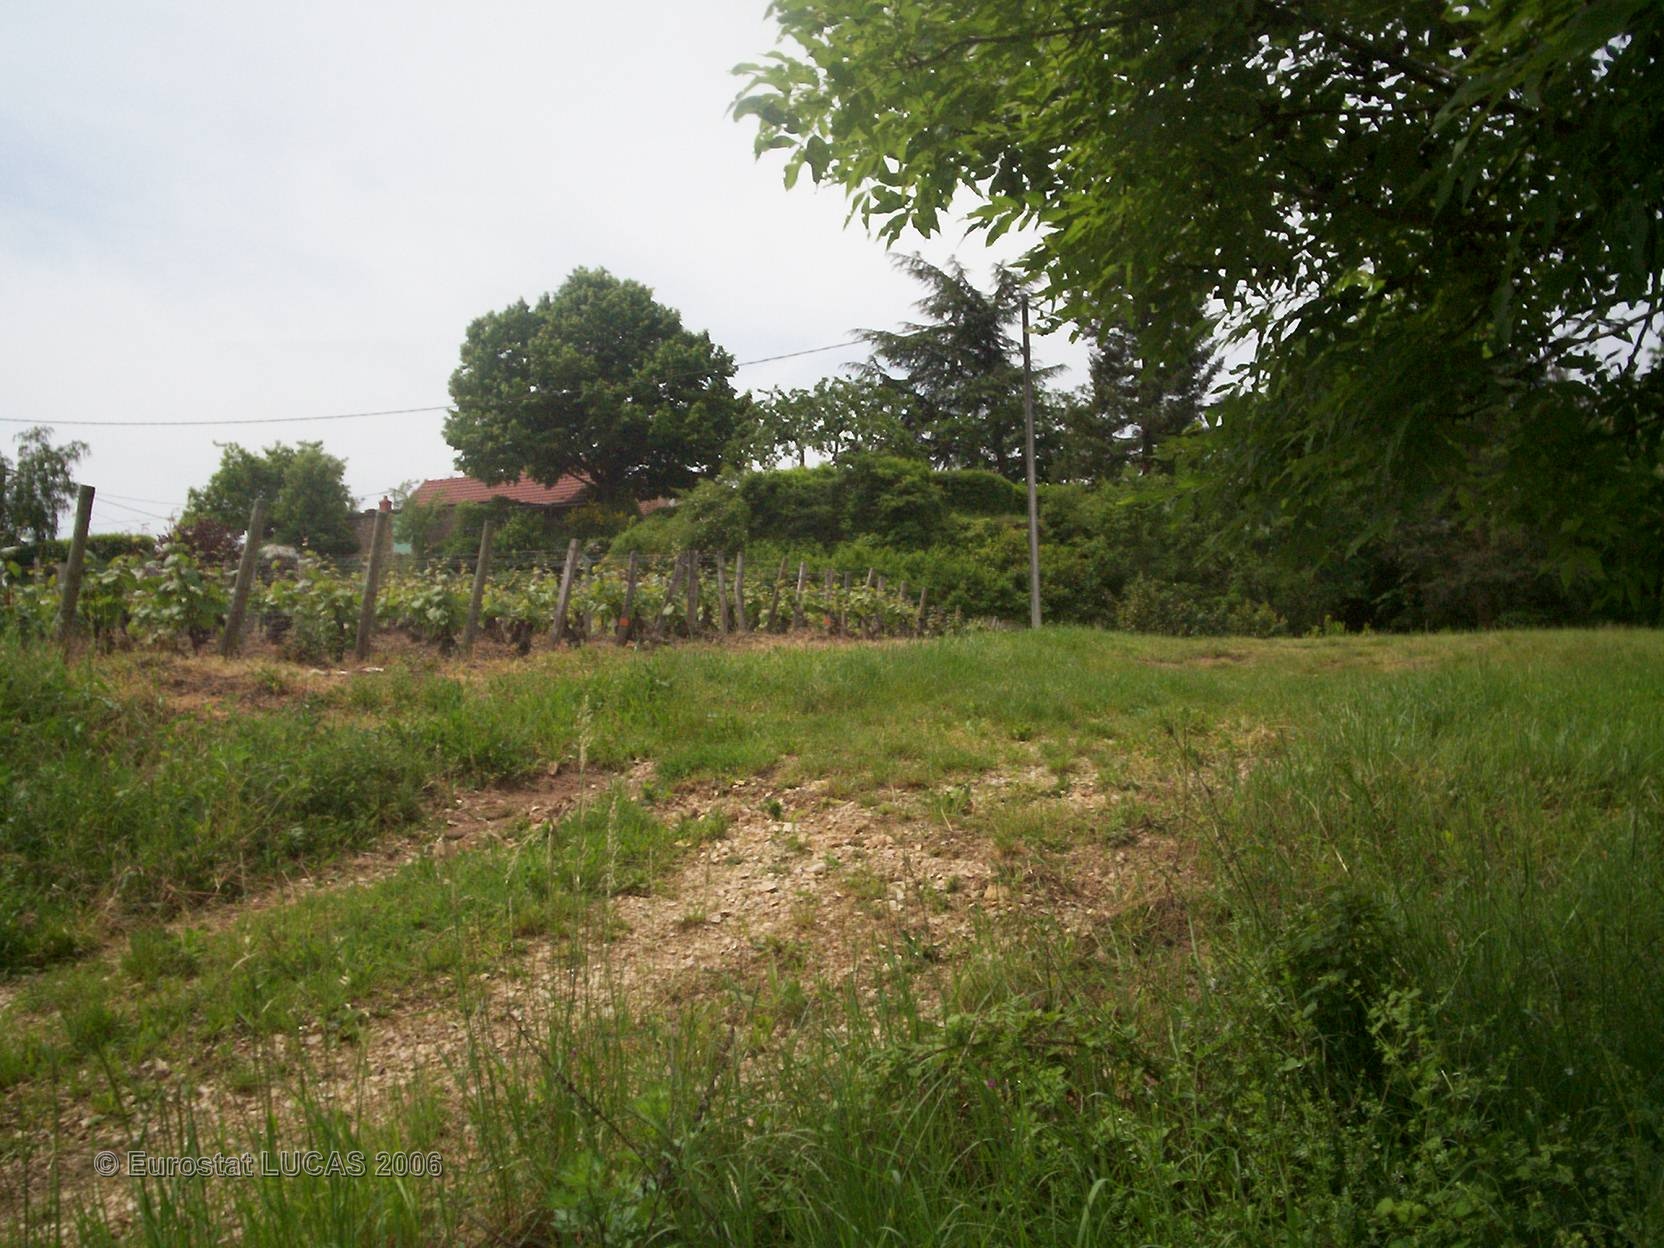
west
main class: Cropland
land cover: Apple fruit
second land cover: Grassland with sparse tree/shrub cover
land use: Kitchen garden
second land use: Residential
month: May
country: FR
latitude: 46.7253
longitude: 4.7020
